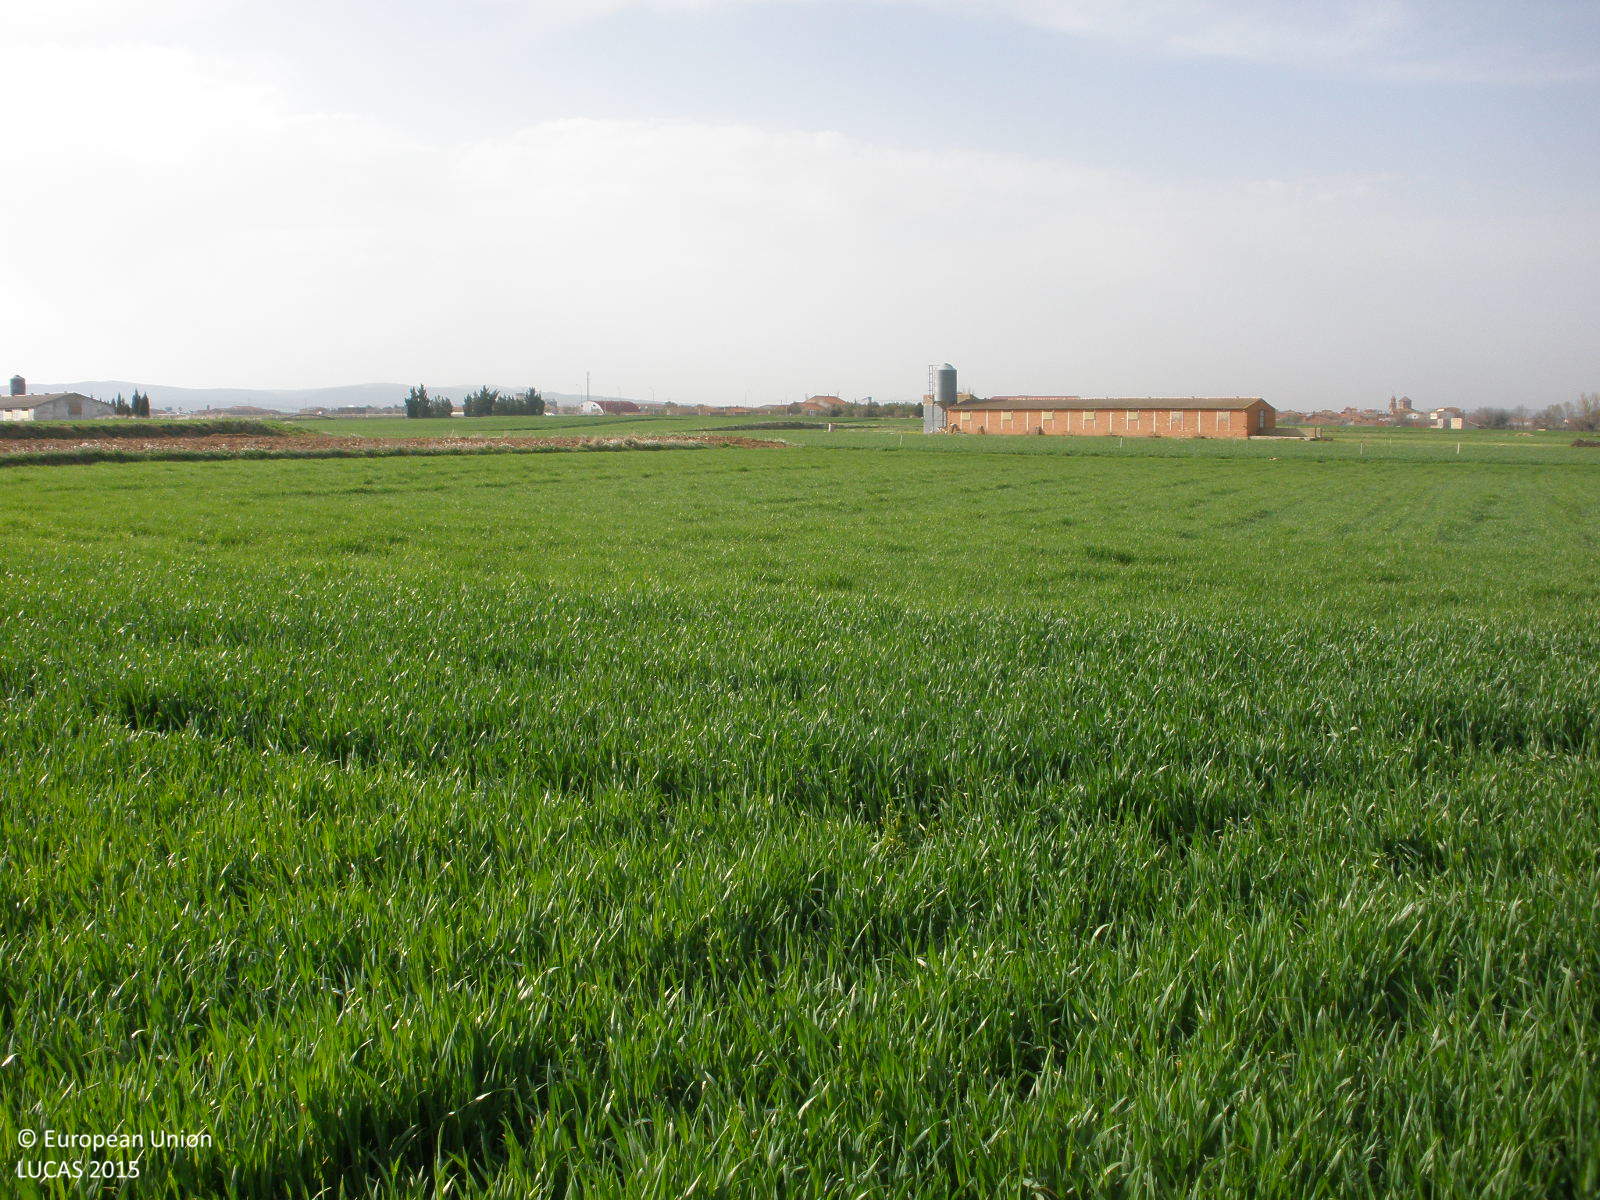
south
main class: Cropland
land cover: Common wheat
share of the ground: > 75 %
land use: Agriculture (excluding fallow land and kitchen gardens)
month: April
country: ES
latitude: 40.8505
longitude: -1.3217
